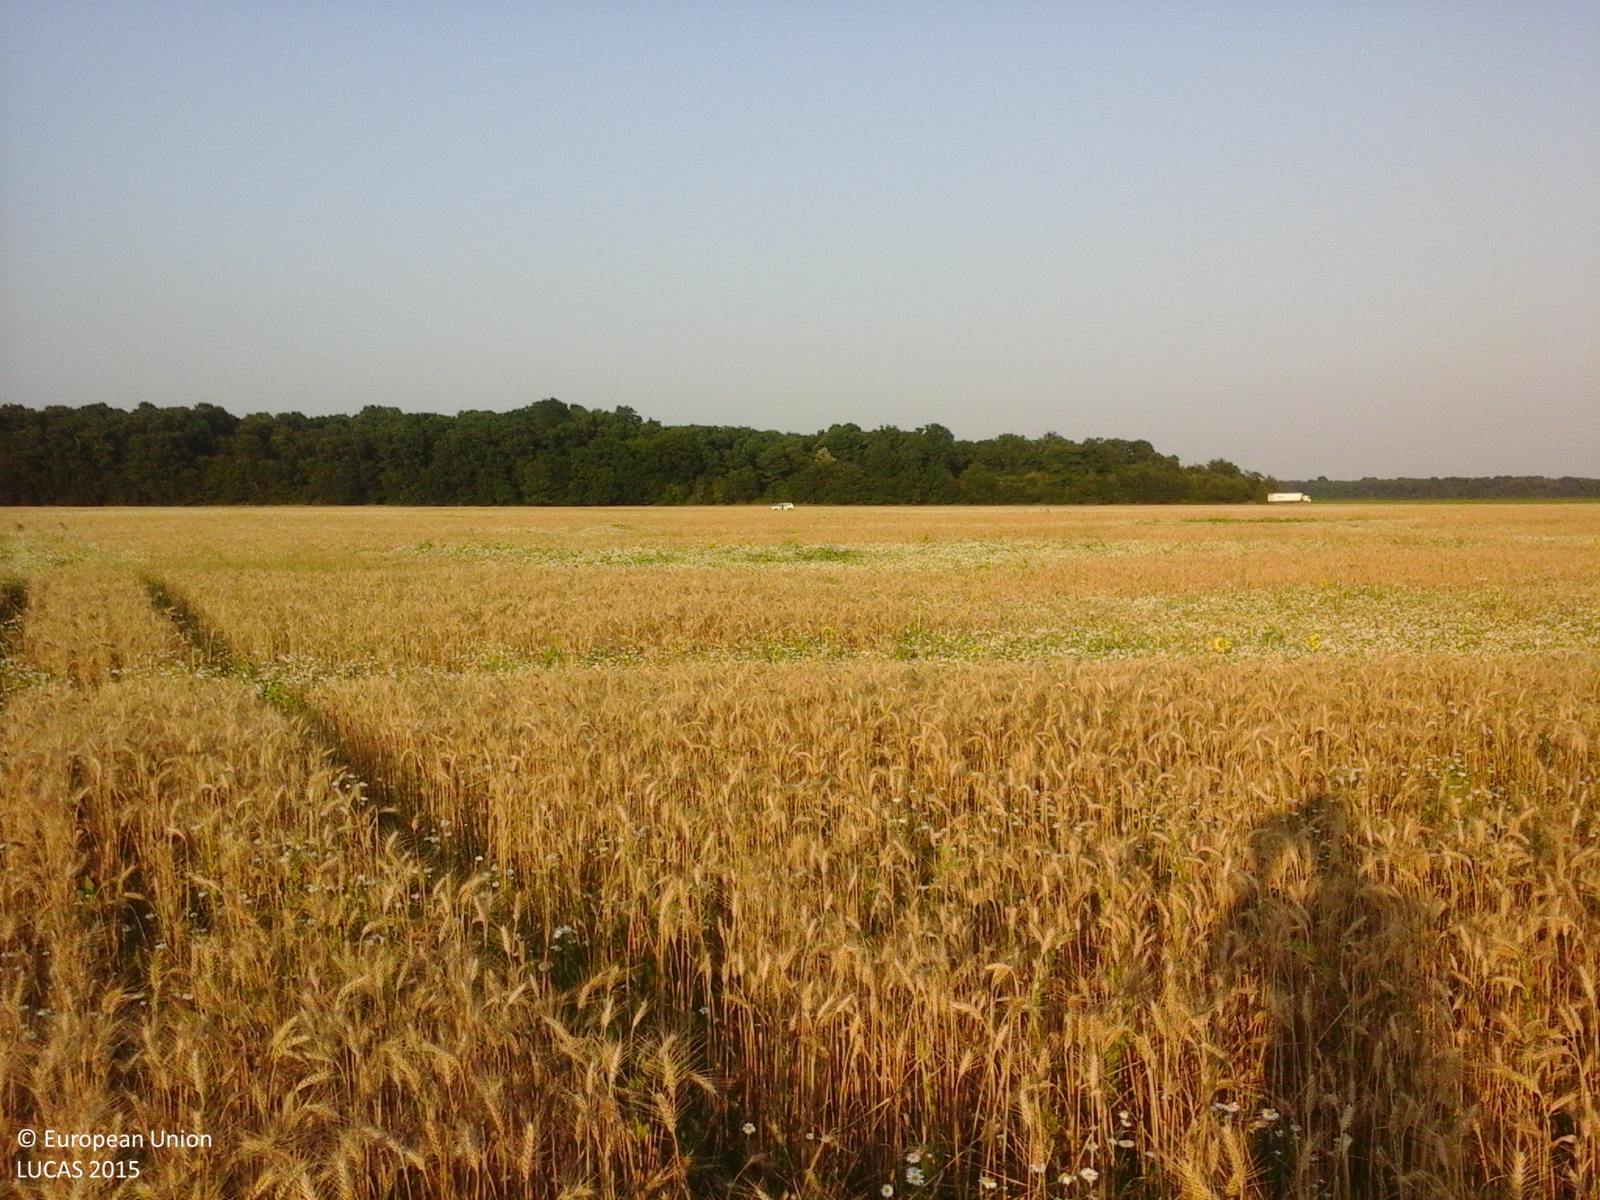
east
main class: Cropland
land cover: Common wheat
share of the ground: > 75 %
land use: Agriculture (excluding fallow land and kitchen gardens)
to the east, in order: Common wheat; Grassland without tree/shrub cover
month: July
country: RO
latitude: 44.7080
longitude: 25.6861
